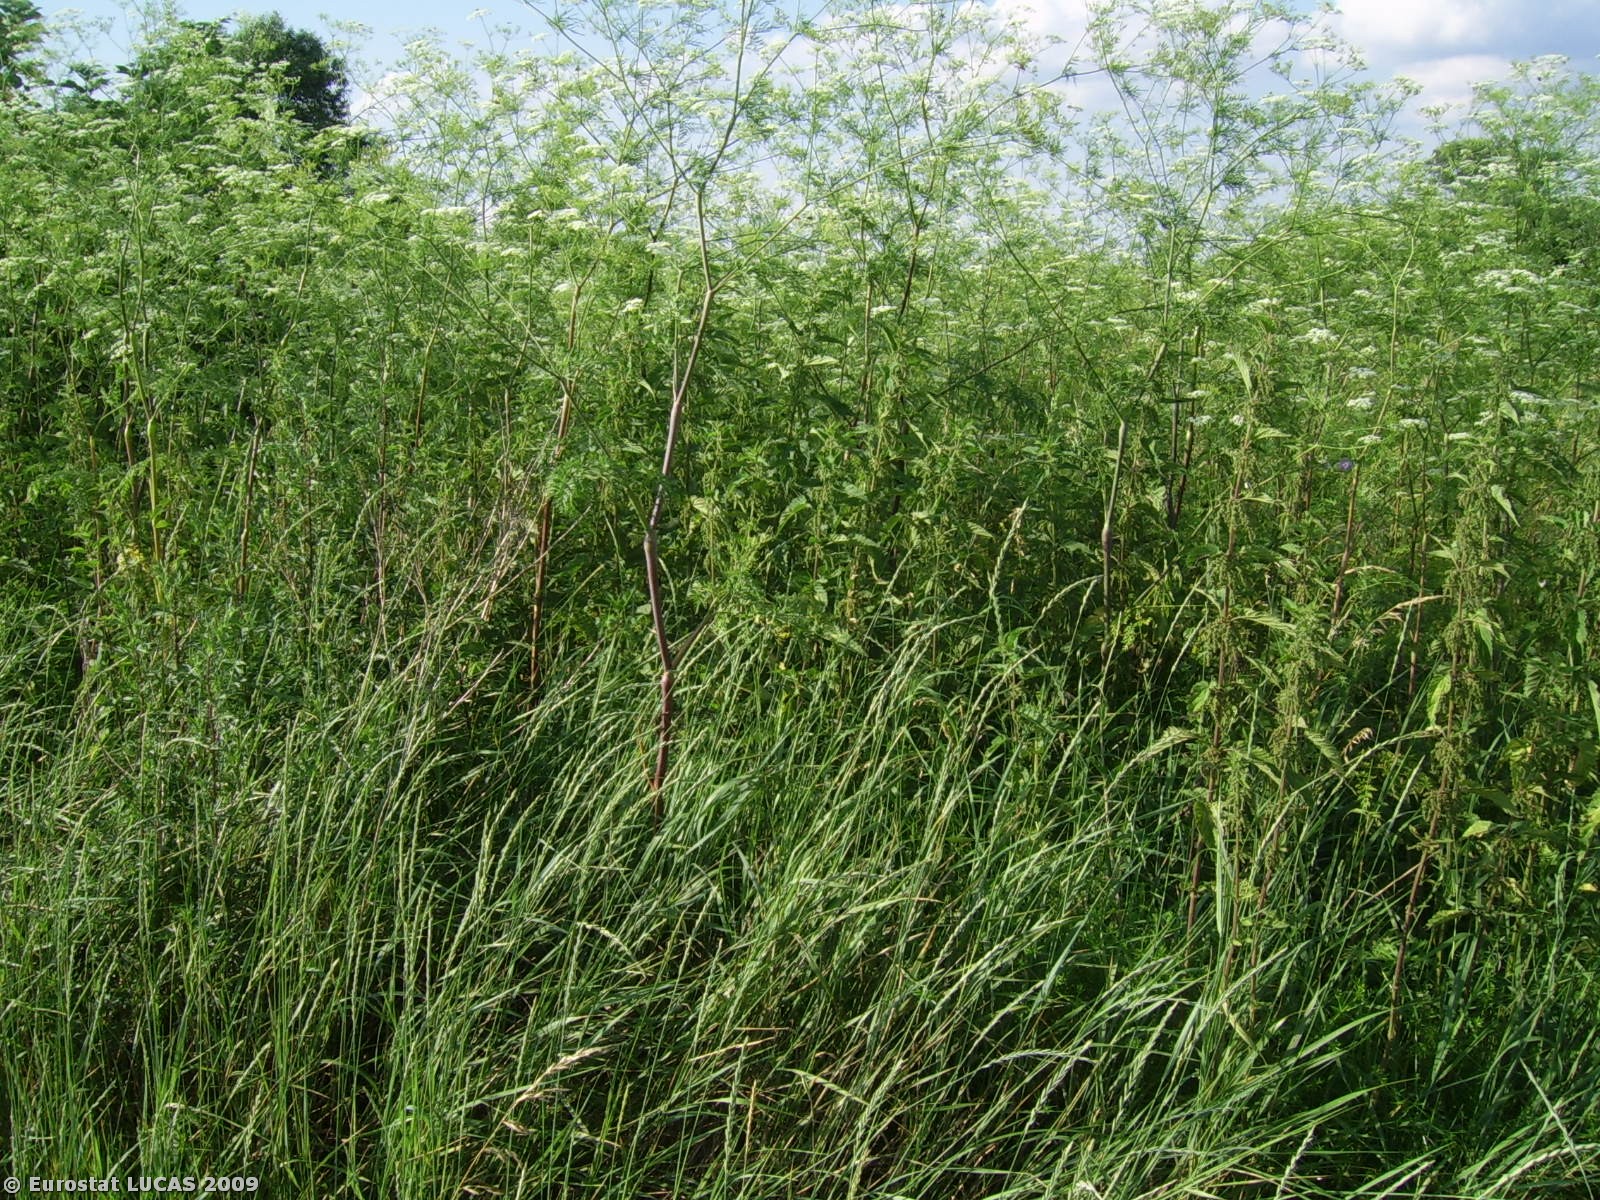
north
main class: Cropland
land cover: Barley
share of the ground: > 75 %
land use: Agriculture (excluding fallow land and kitchen gardens)
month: July
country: PL
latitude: 52.9260
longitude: 18.1829
